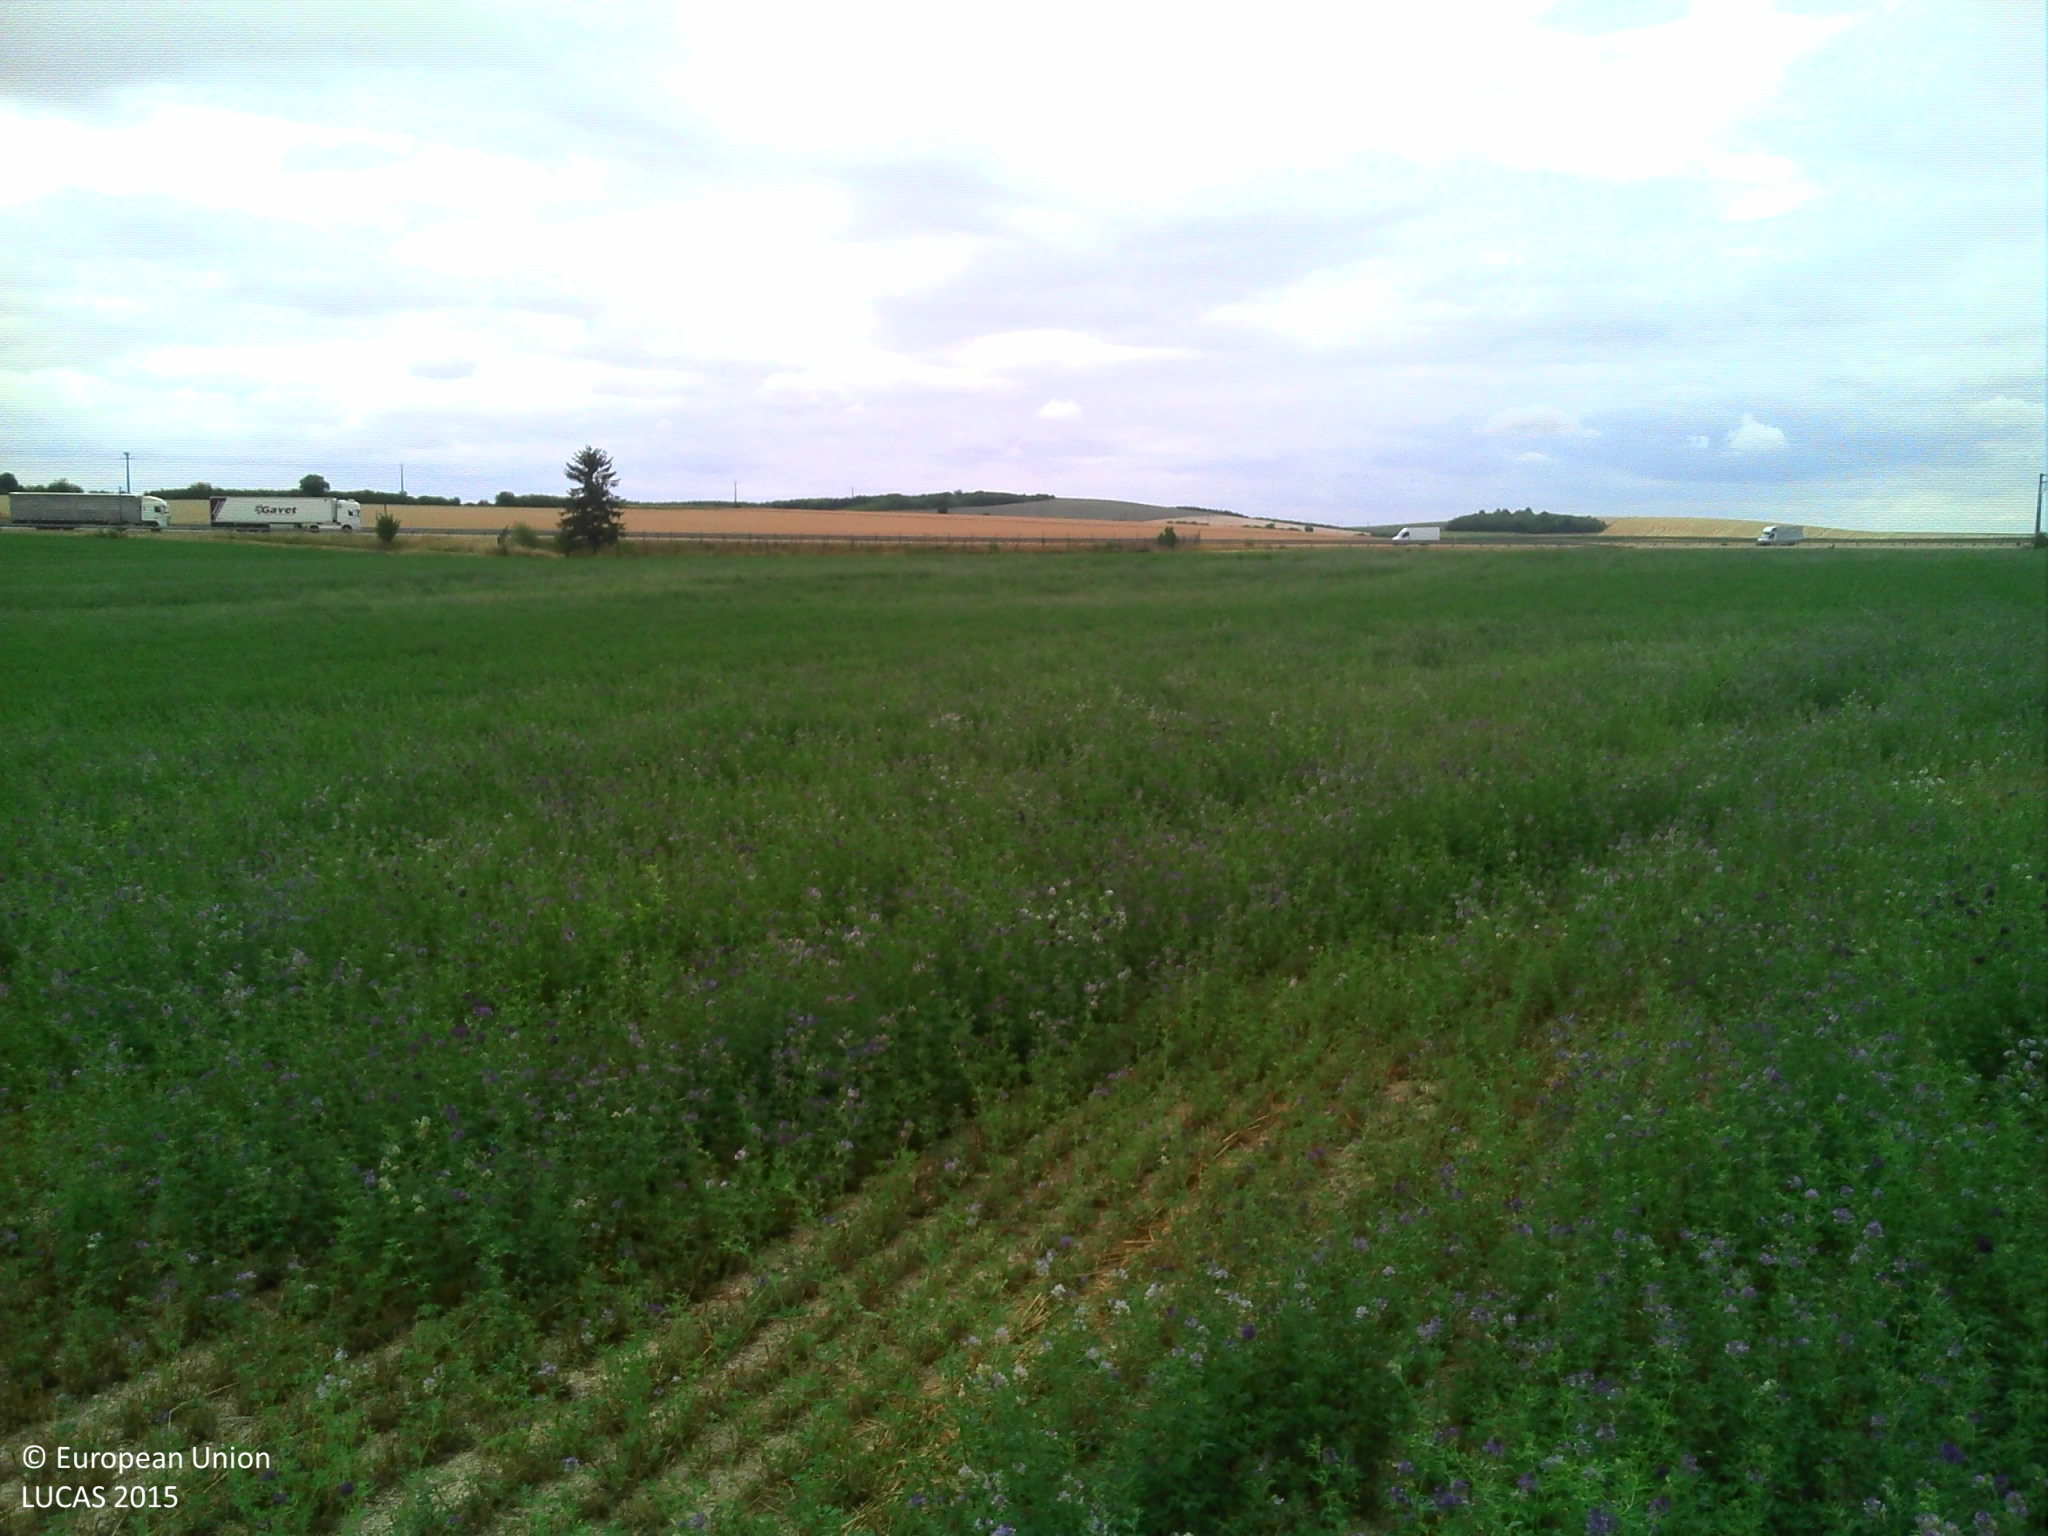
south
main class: Cropland
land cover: Lucerne
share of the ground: > 75 %
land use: Agriculture (excluding fallow land and kitchen gardens)
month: July
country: FR
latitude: 48.7378
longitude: 4.1899
